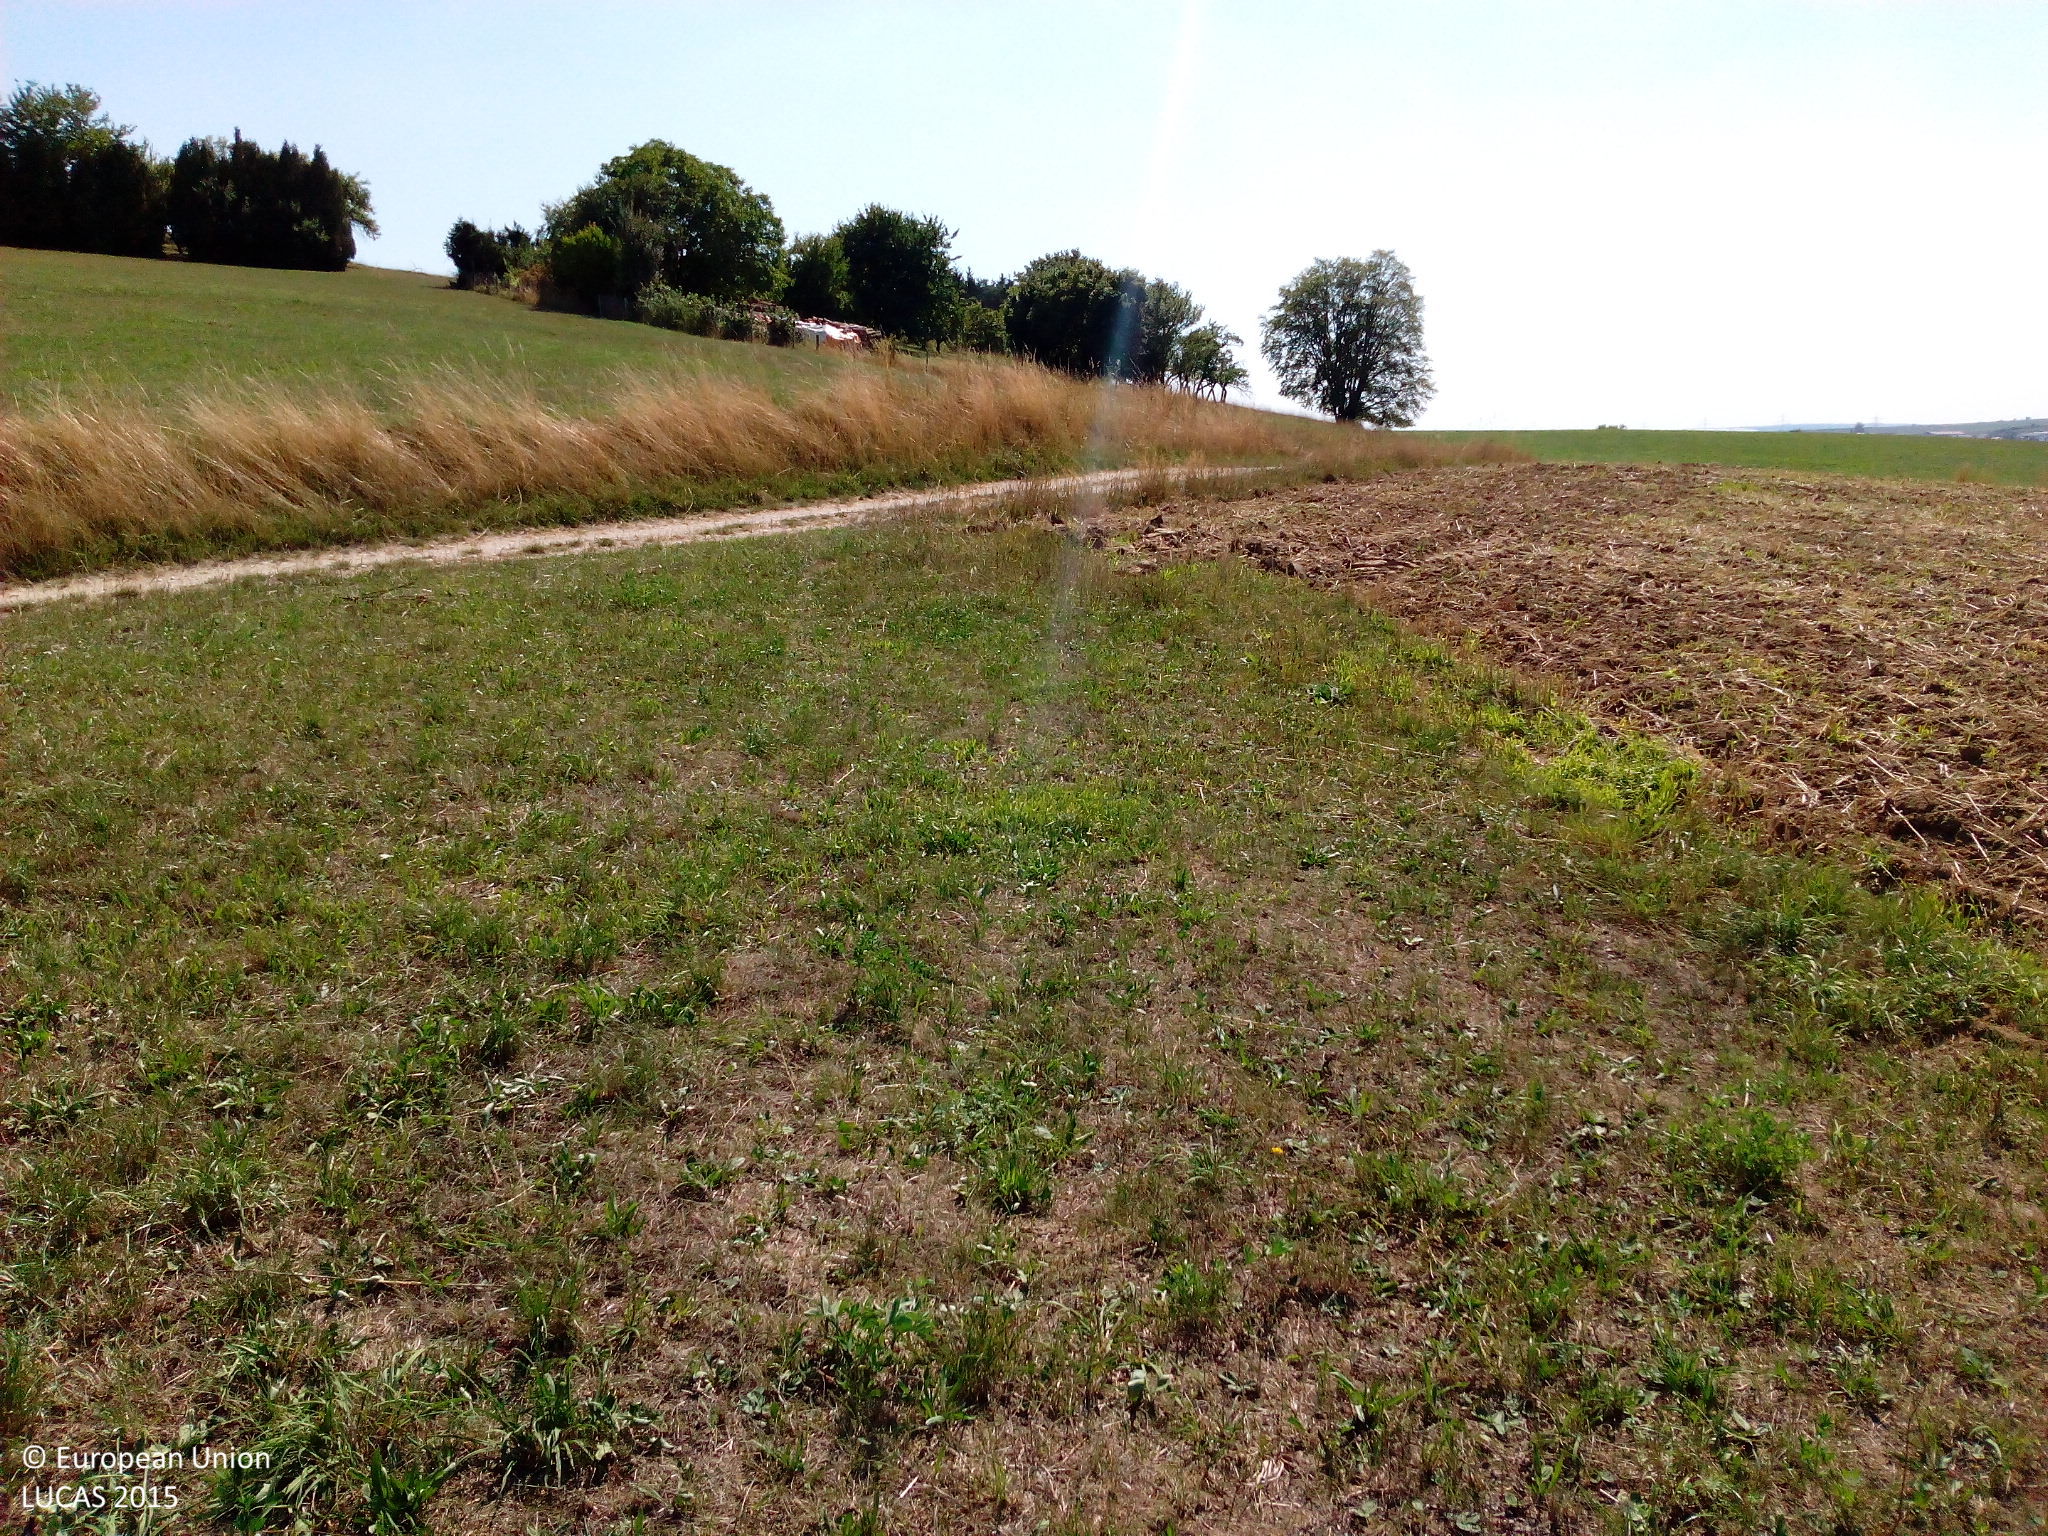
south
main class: Grassland
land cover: Grassland without tree/shrub cover
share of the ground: 50 - 75 %
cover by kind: herbaceous plants 70 %, unconsolidated bare surface 30 %
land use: Agriculture (excluding fallow land and kitchen gardens)
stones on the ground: < 10 %
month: August
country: DE
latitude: 48.6549
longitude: 10.3121
